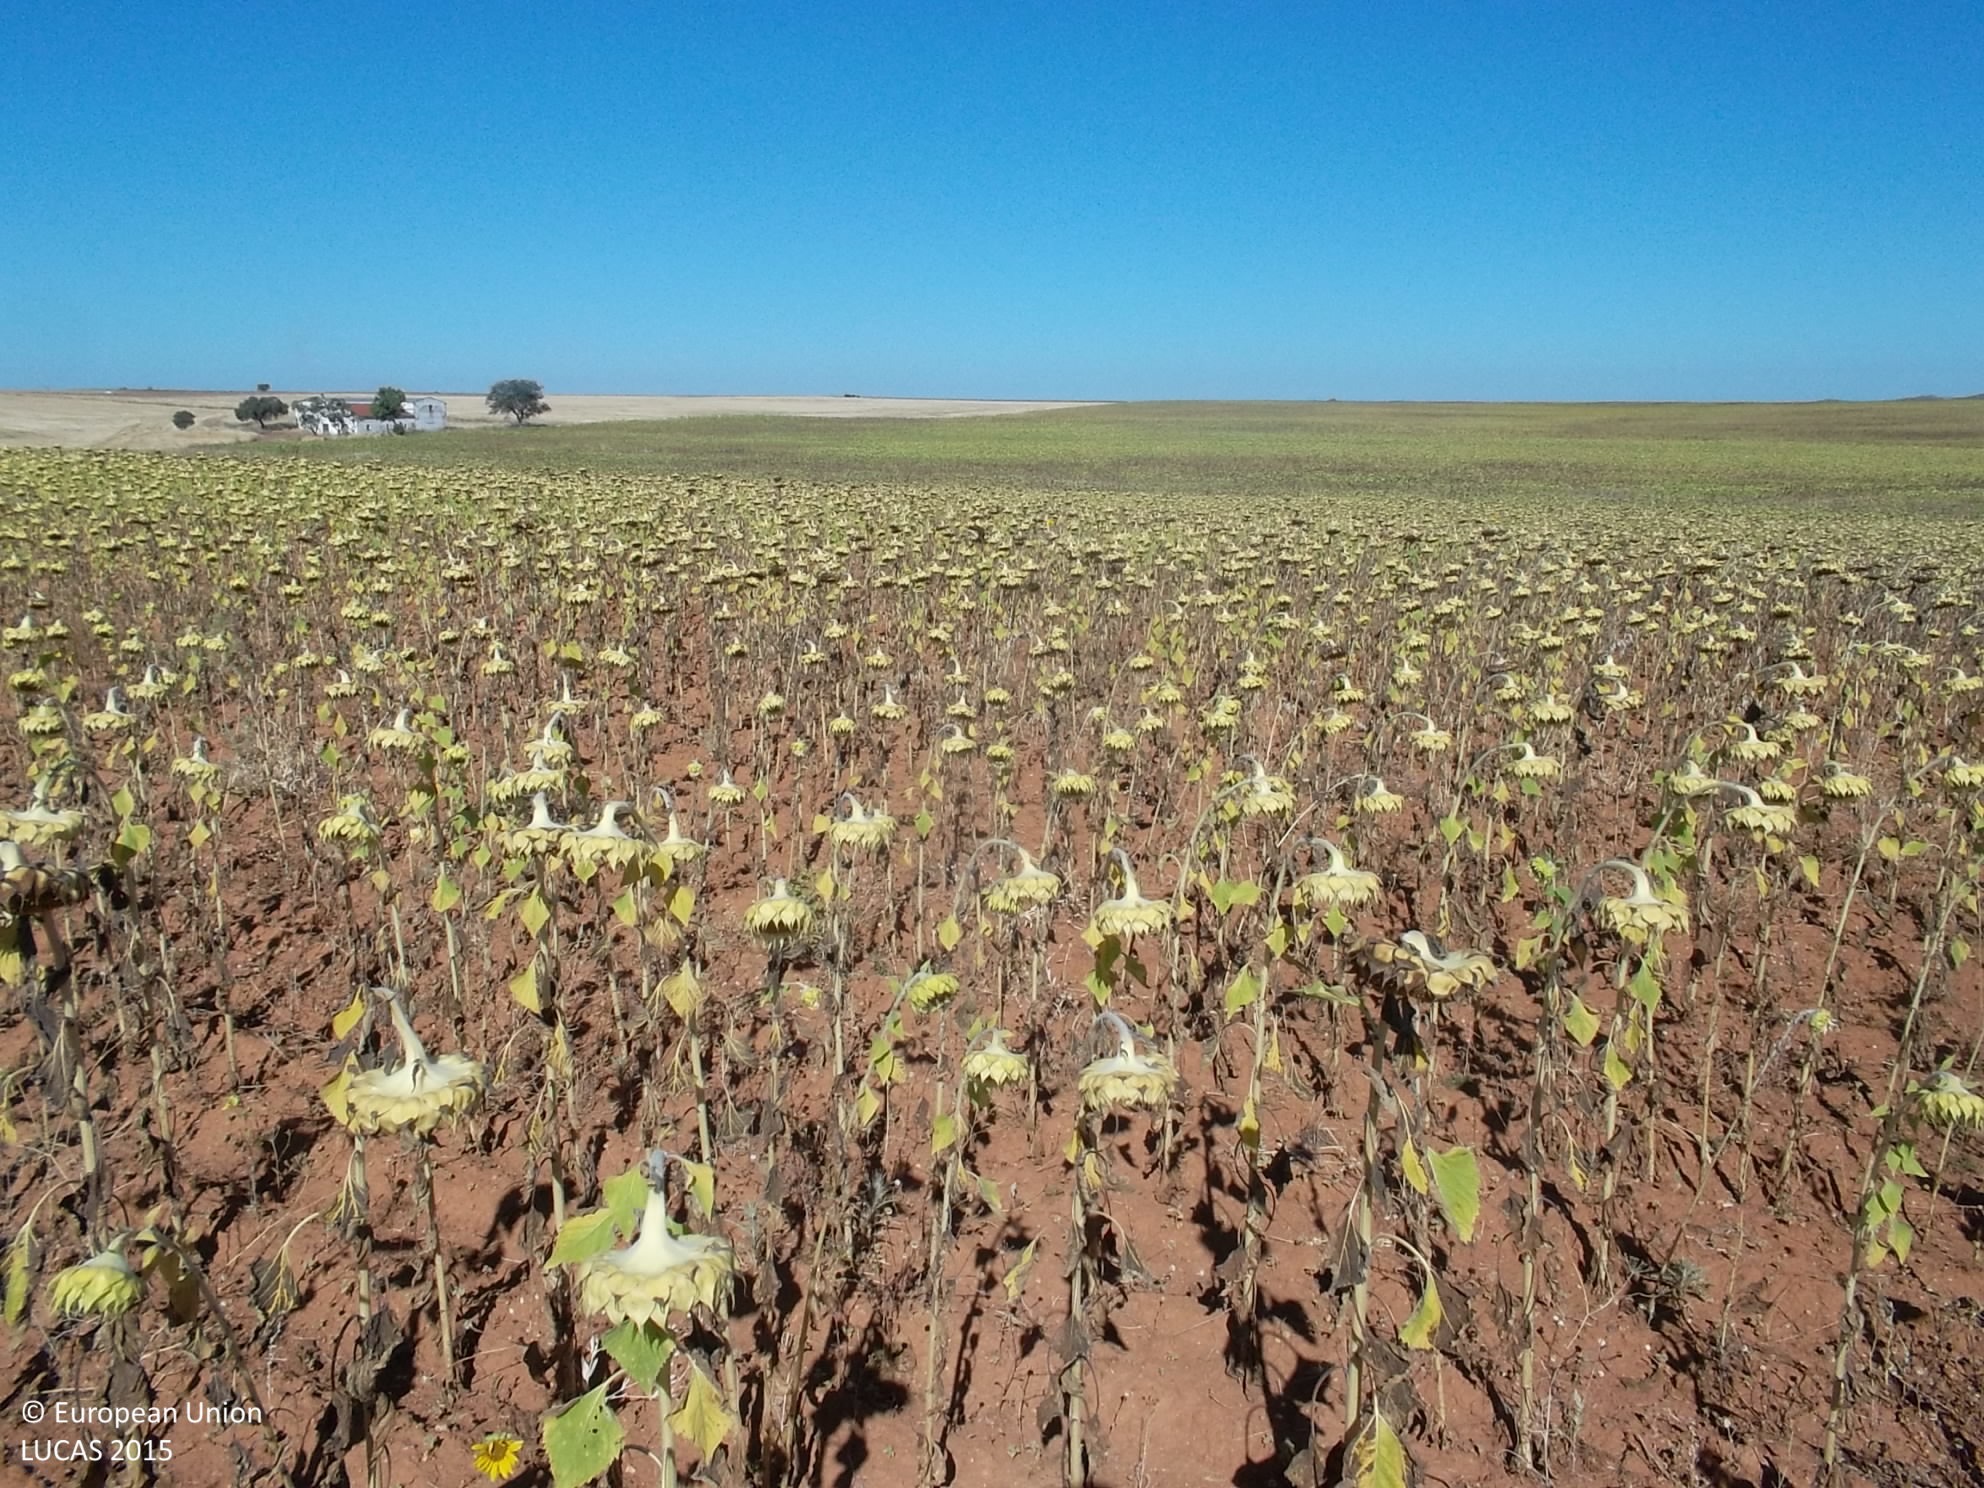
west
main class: Cropland
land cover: Sunflower
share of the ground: > 75 %
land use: Agriculture (excluding fallow land and kitchen gardens)
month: July
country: ES
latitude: 38.3819
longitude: -5.7320
